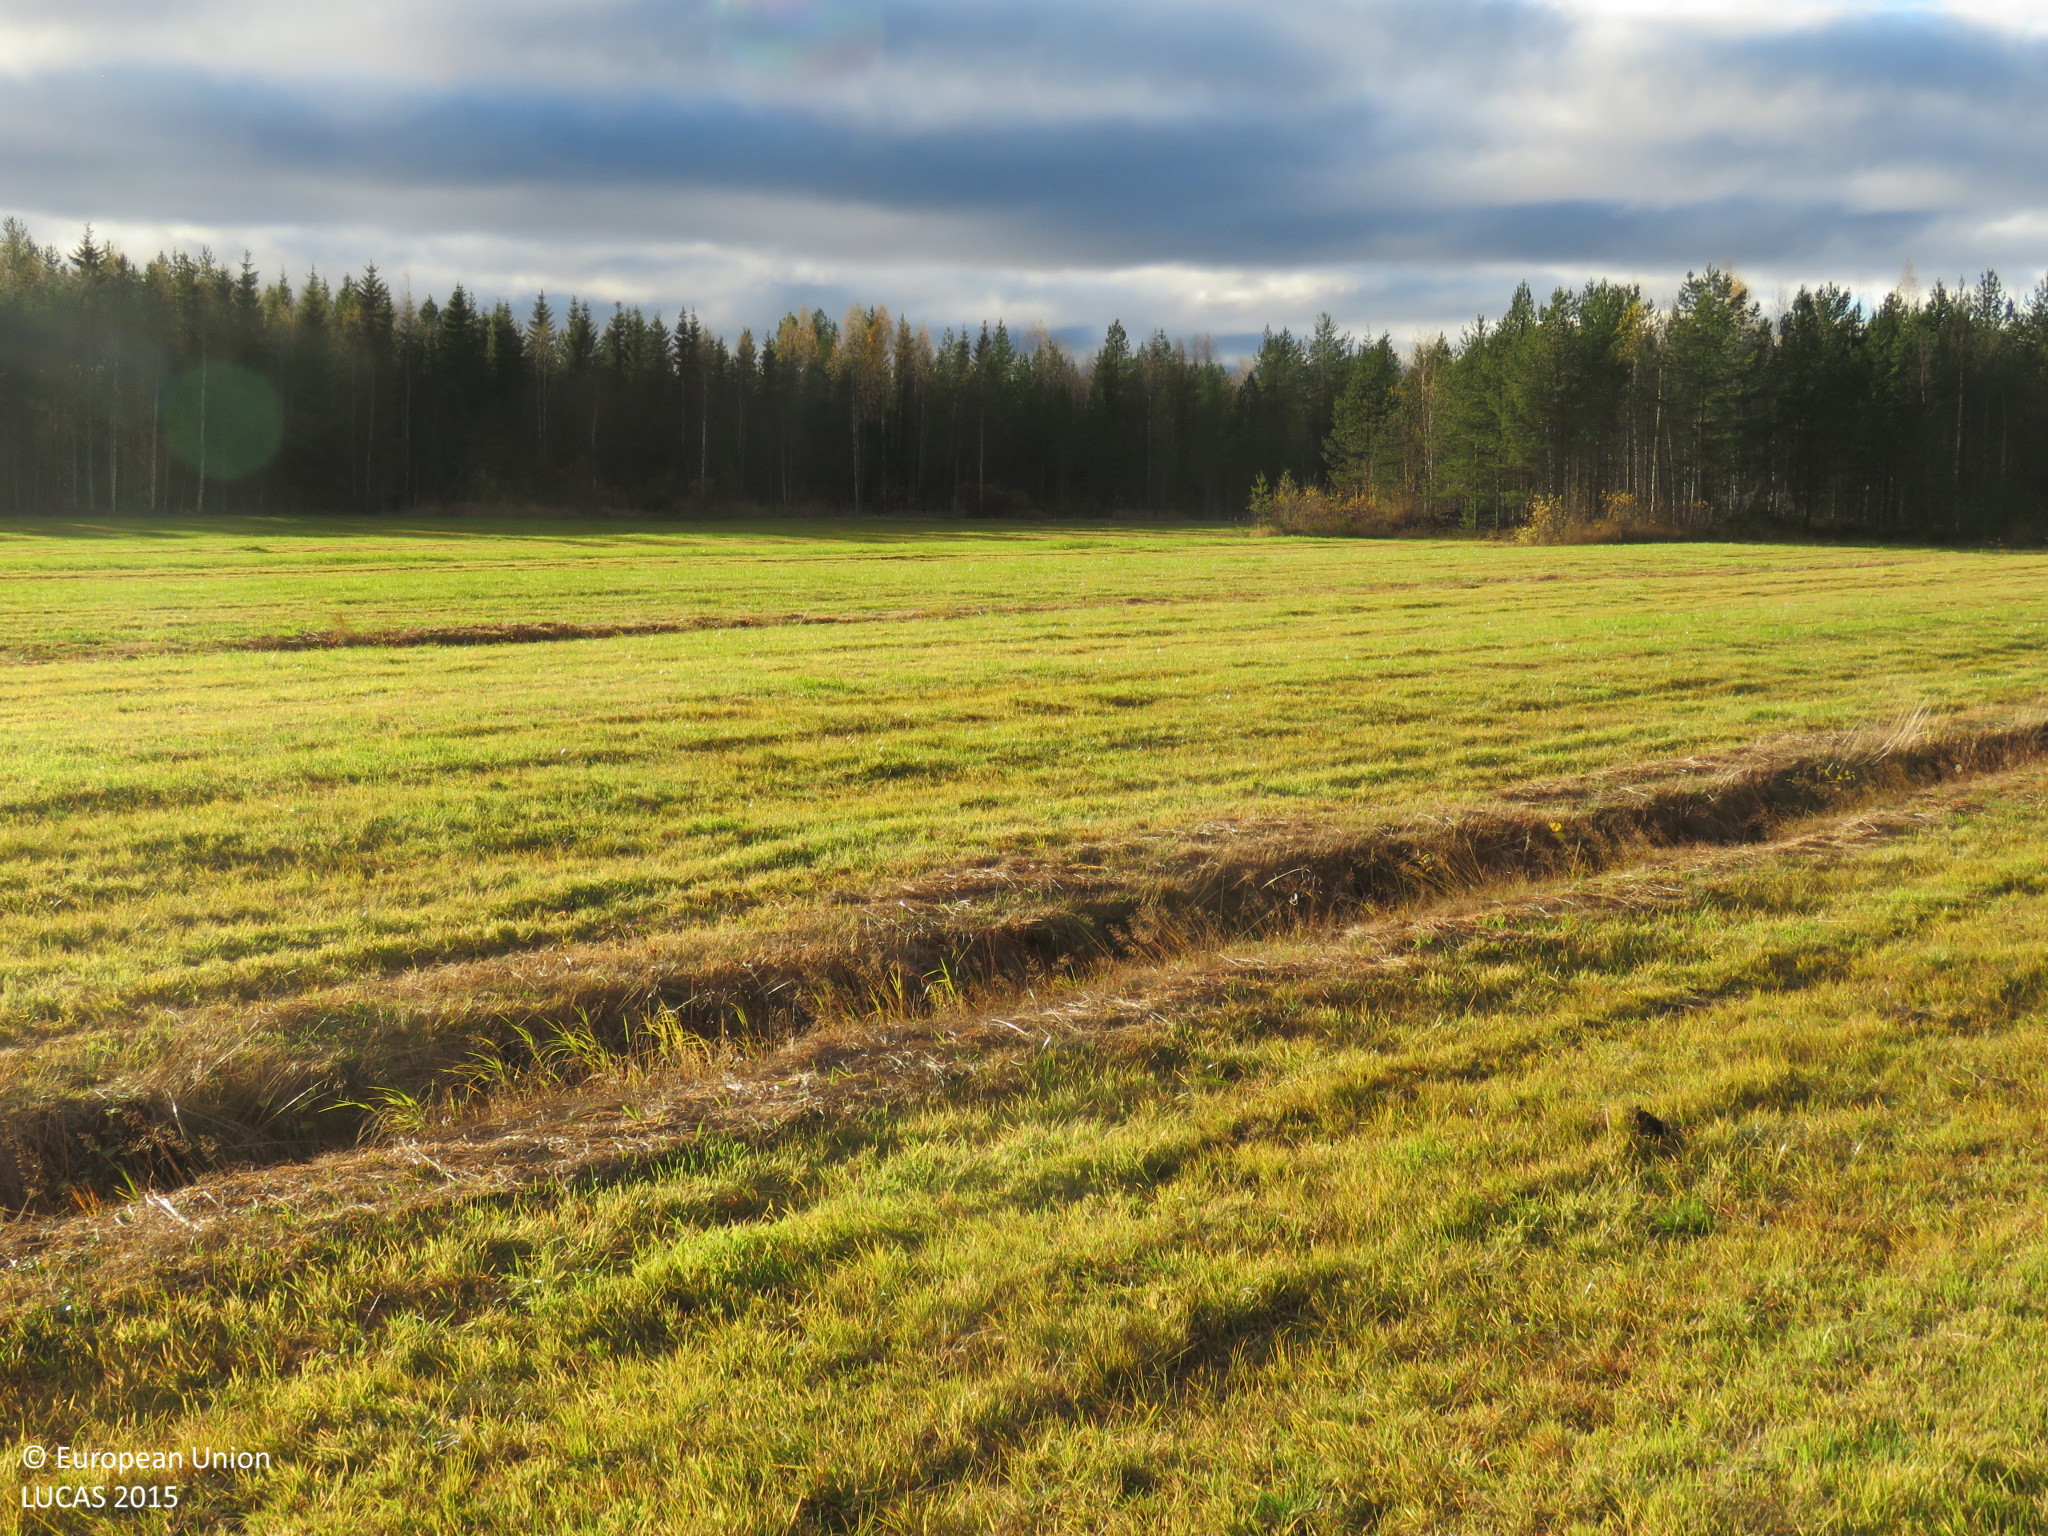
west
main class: Cropland
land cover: Temporary grasslands
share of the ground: > 75 %
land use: Agriculture (excluding fallow land and kitchen gardens)
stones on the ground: < 10 %
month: October
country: FI
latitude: 64.5564
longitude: 27.0906
